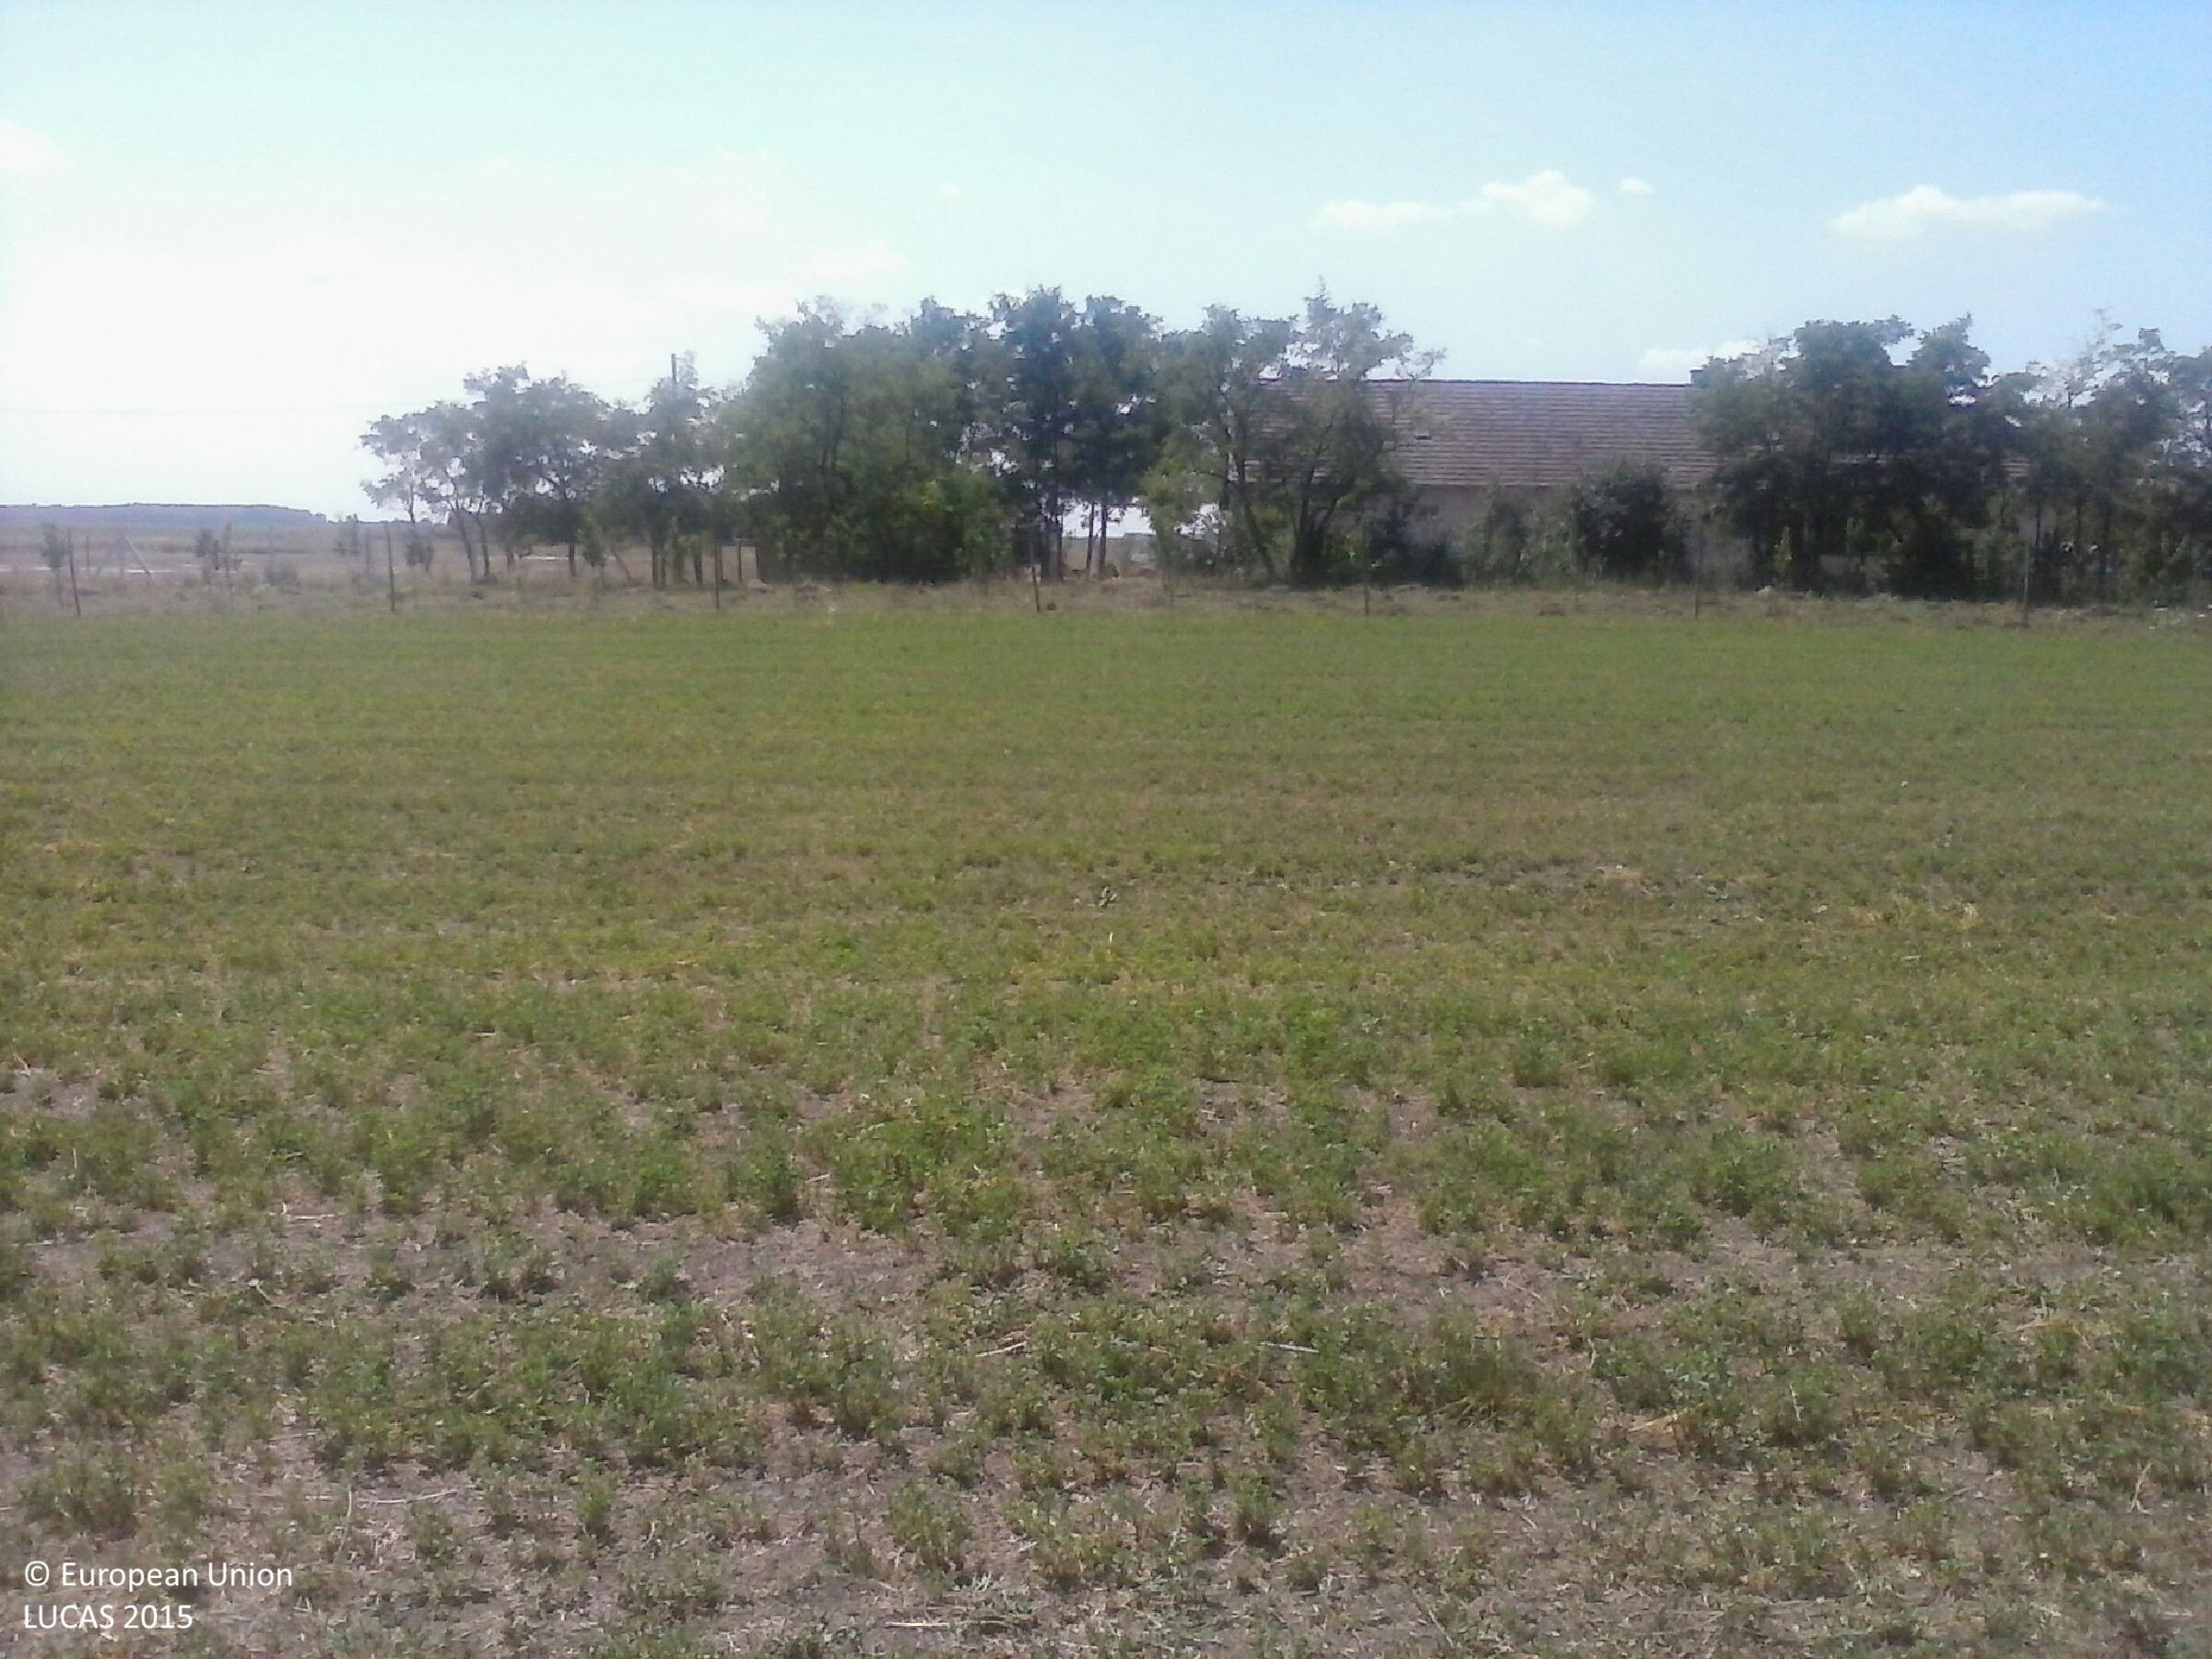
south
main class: Cropland
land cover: Lucerne
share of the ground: > 75 %
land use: Agriculture (excluding fallow land and kitchen gardens)
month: July
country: HU
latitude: 46.6880
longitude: 20.1046
